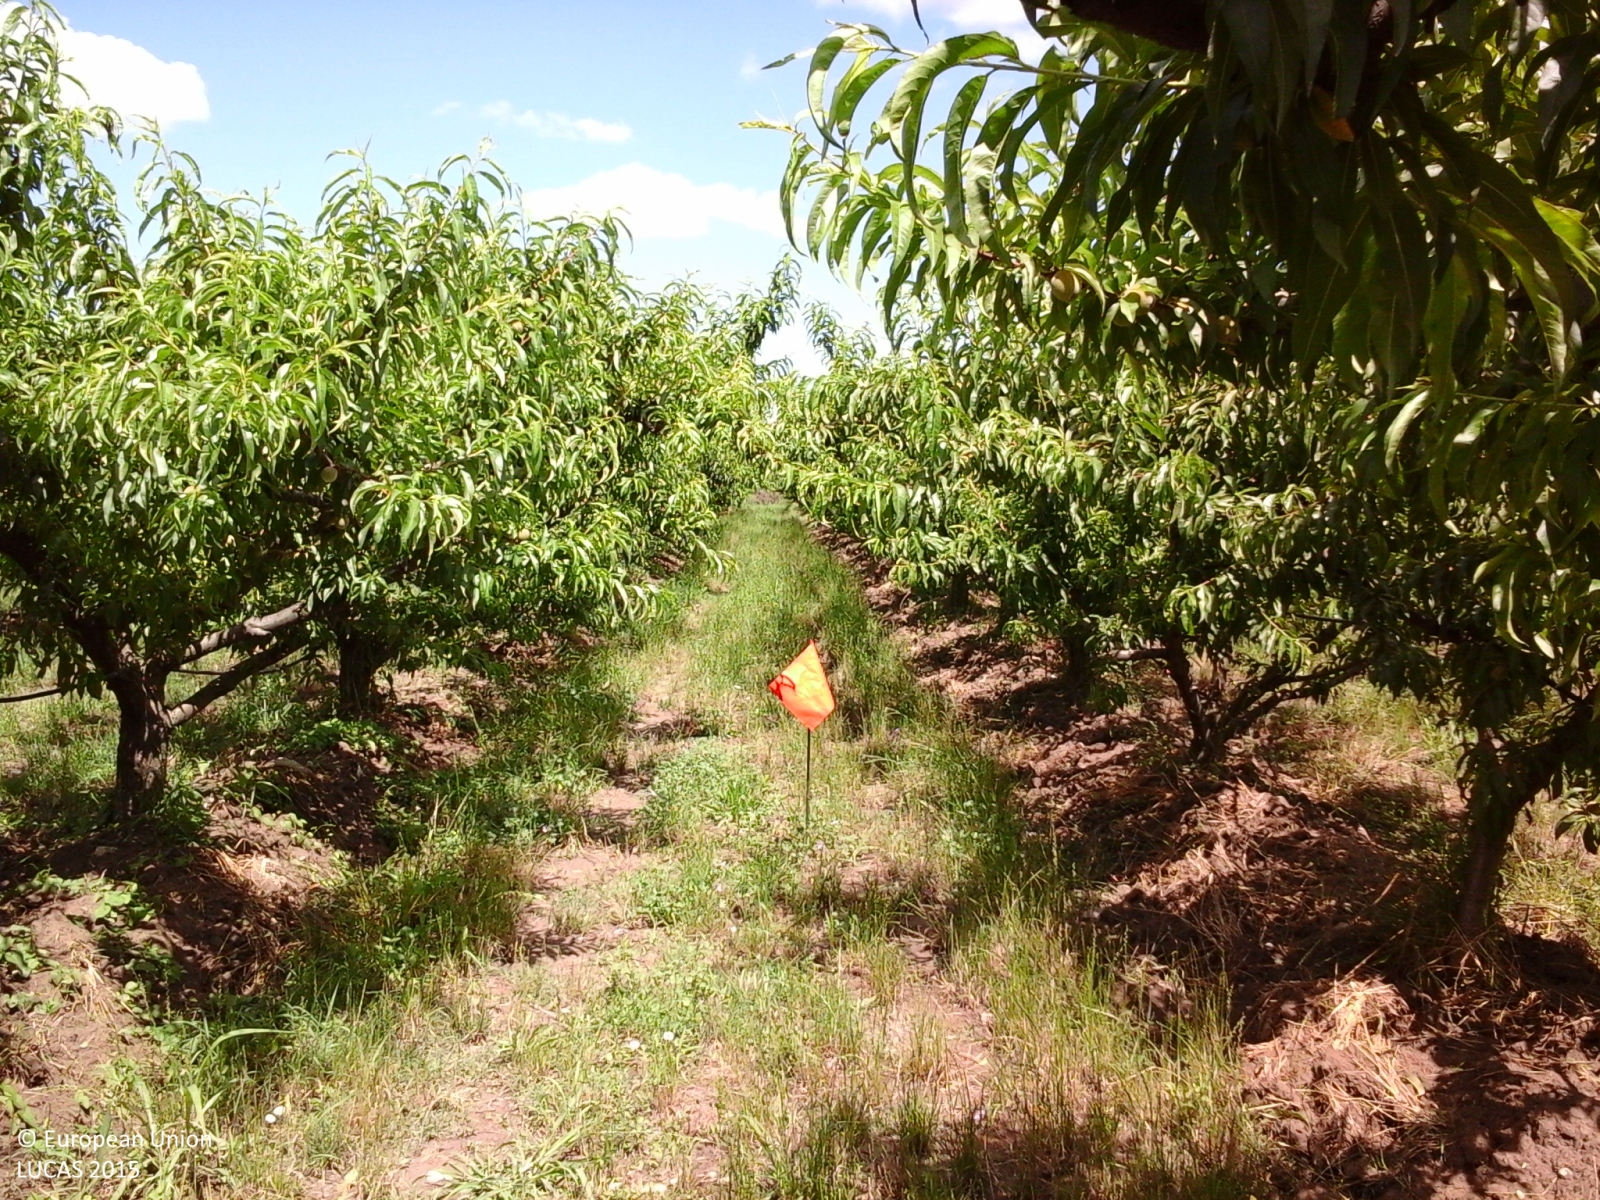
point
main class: Cropland
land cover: Other fruit trees and berries
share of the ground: 50 - 75 %
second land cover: Grassland without tree/shrub cover
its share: > 75 %
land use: Agriculture (excluding fallow land and kitchen gardens)
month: June
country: IT
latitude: 44.2839
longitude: 11.6128
